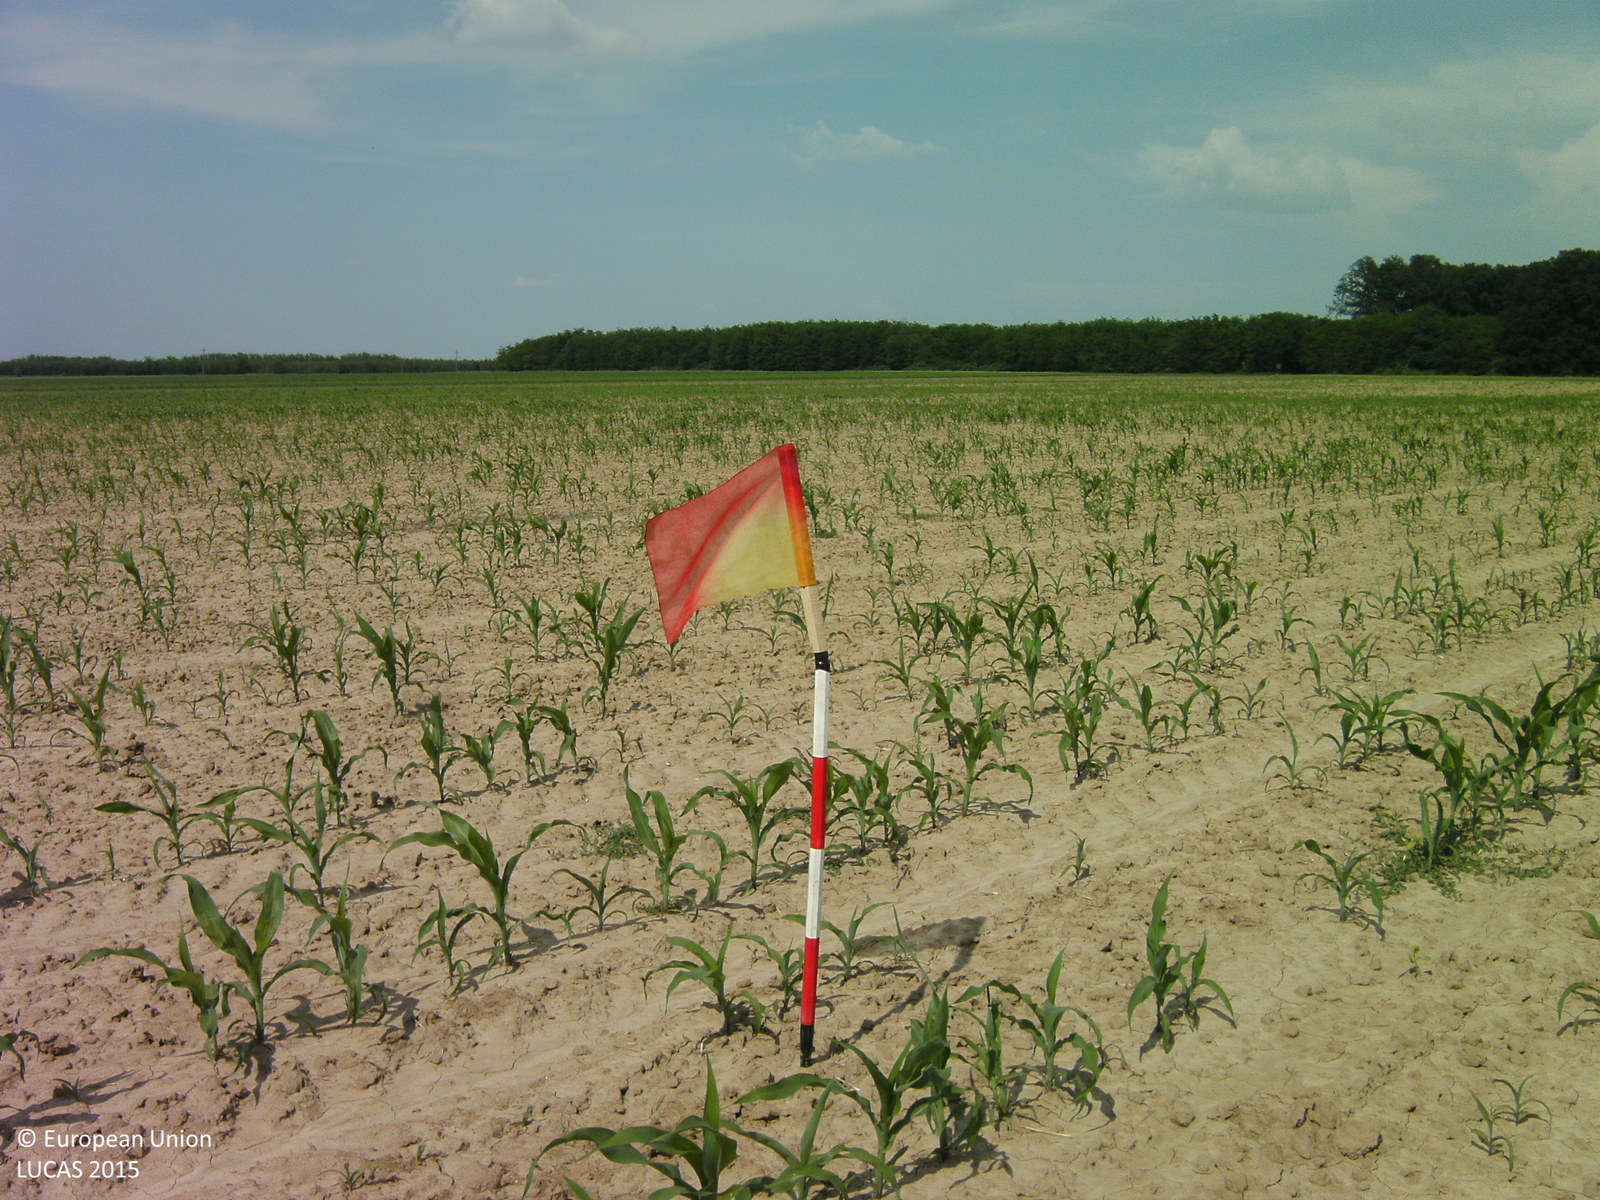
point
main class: Cropland
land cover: Maize
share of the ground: 10 - 25 %
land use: Agriculture (excluding fallow land and kitchen gardens)
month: June
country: HU
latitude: 46.4316
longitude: 17.7492
